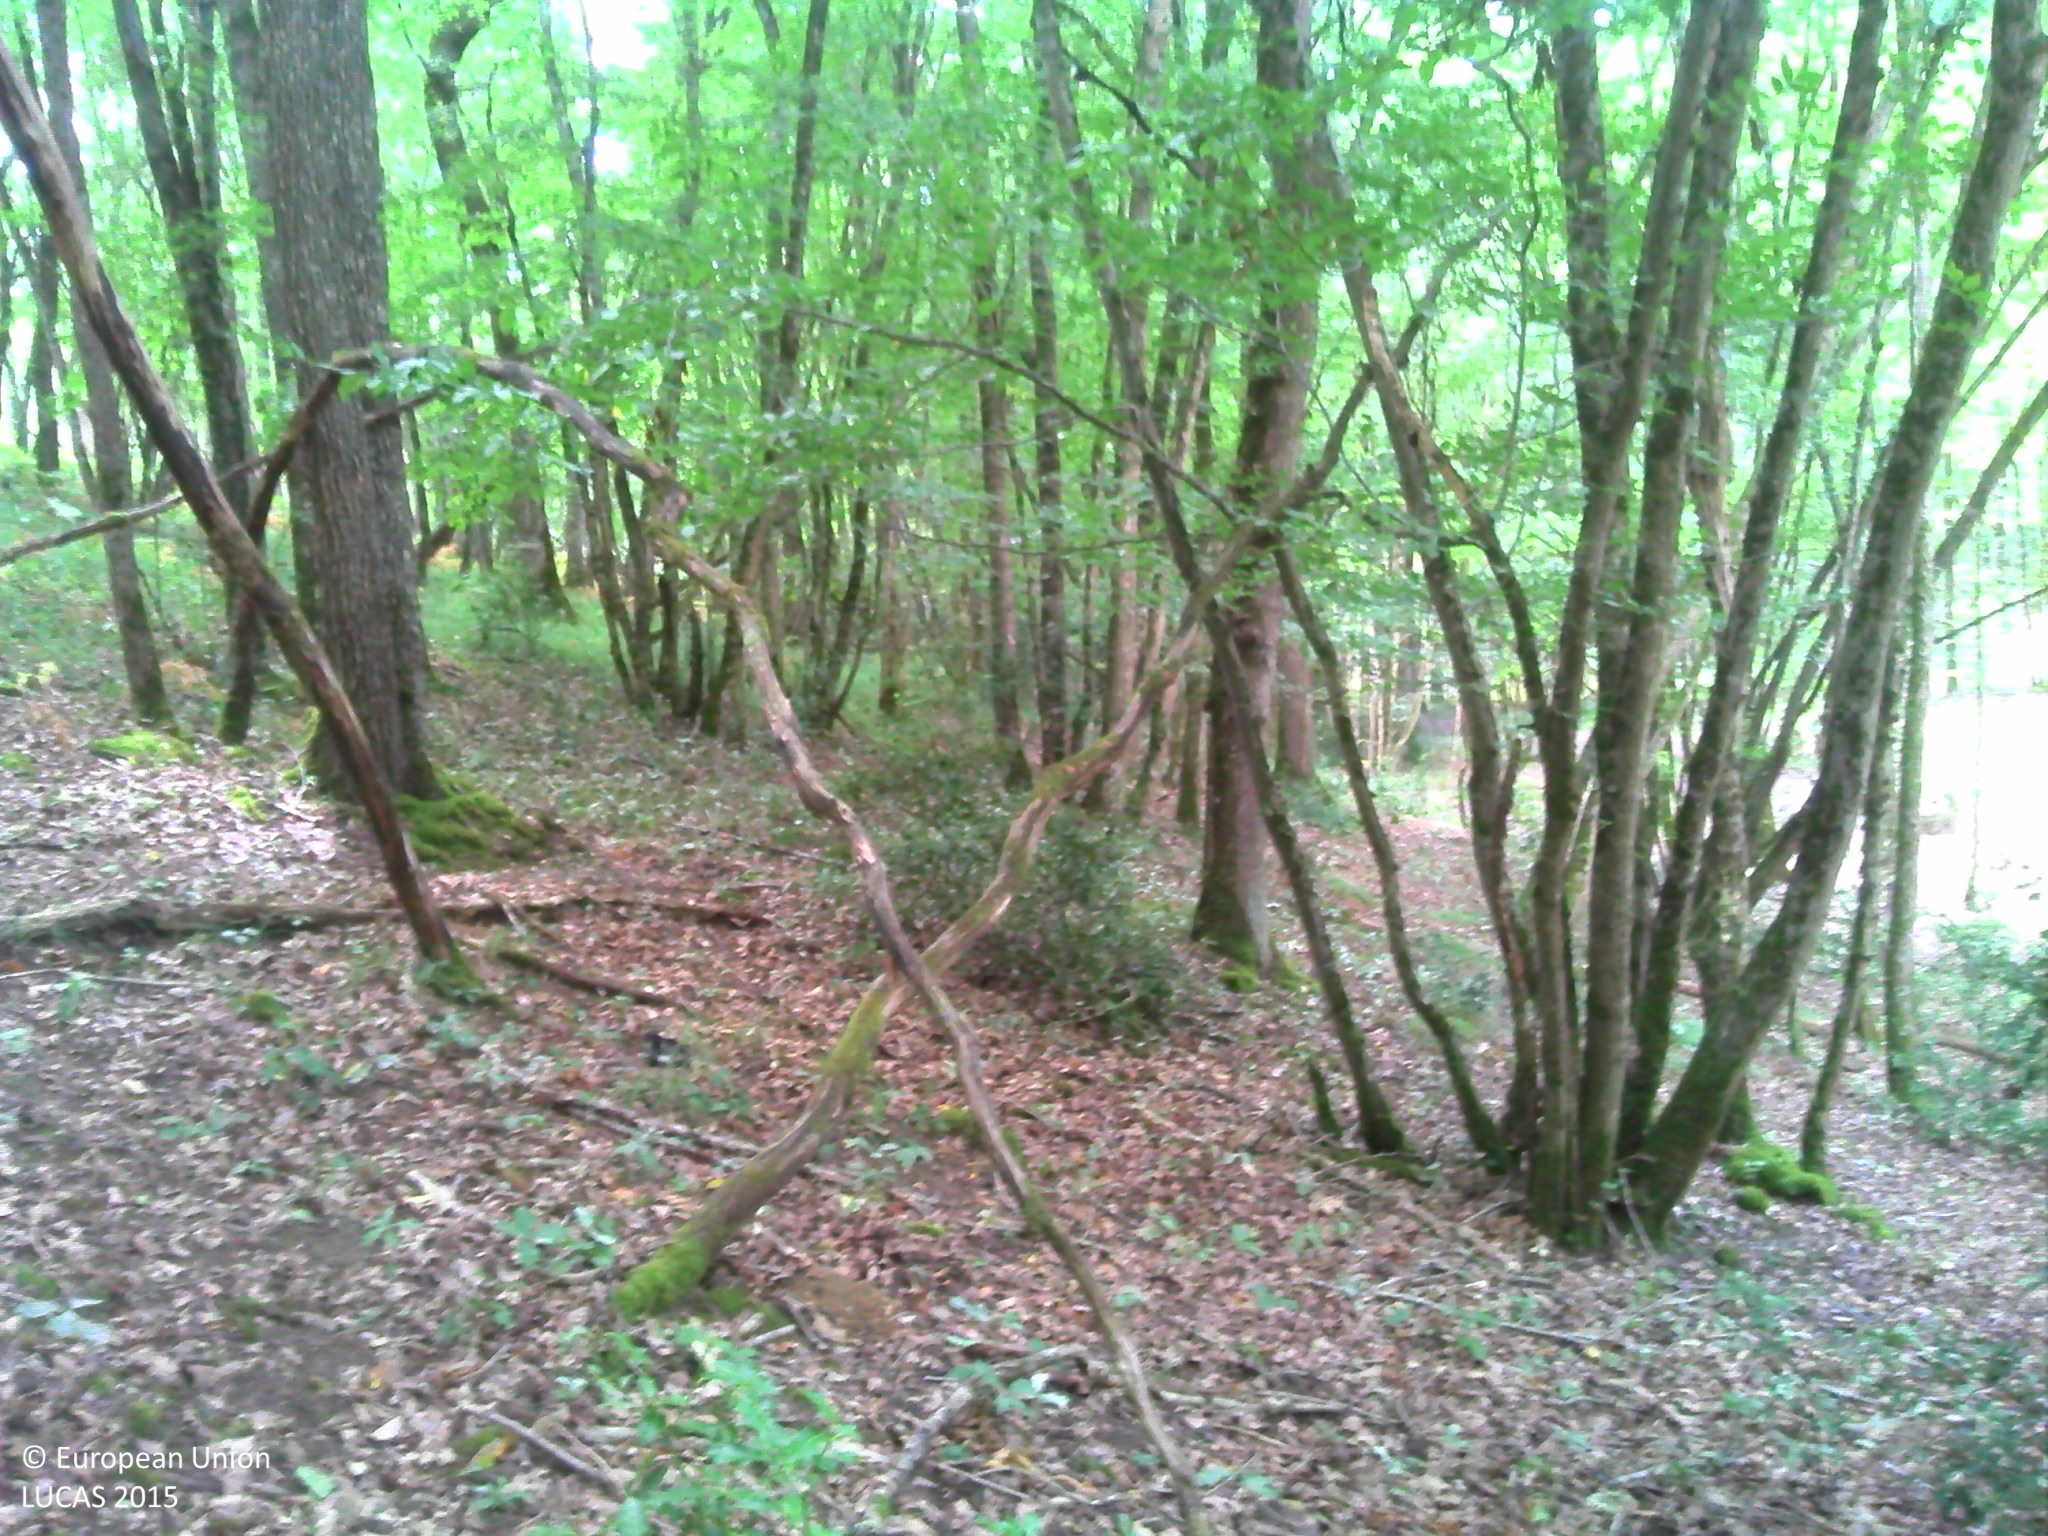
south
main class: Woodland
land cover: Broadleaved woodland
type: mesophytic deciduous forest
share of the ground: > 75 %
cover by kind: broadleaved forest trees 85 %, shrubs 5 %, herbaceous plants 5 %, lichens and mosses 5 %
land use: Forestry
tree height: > 5 m
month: July
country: FR
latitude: 46.8970
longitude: 0.8083
